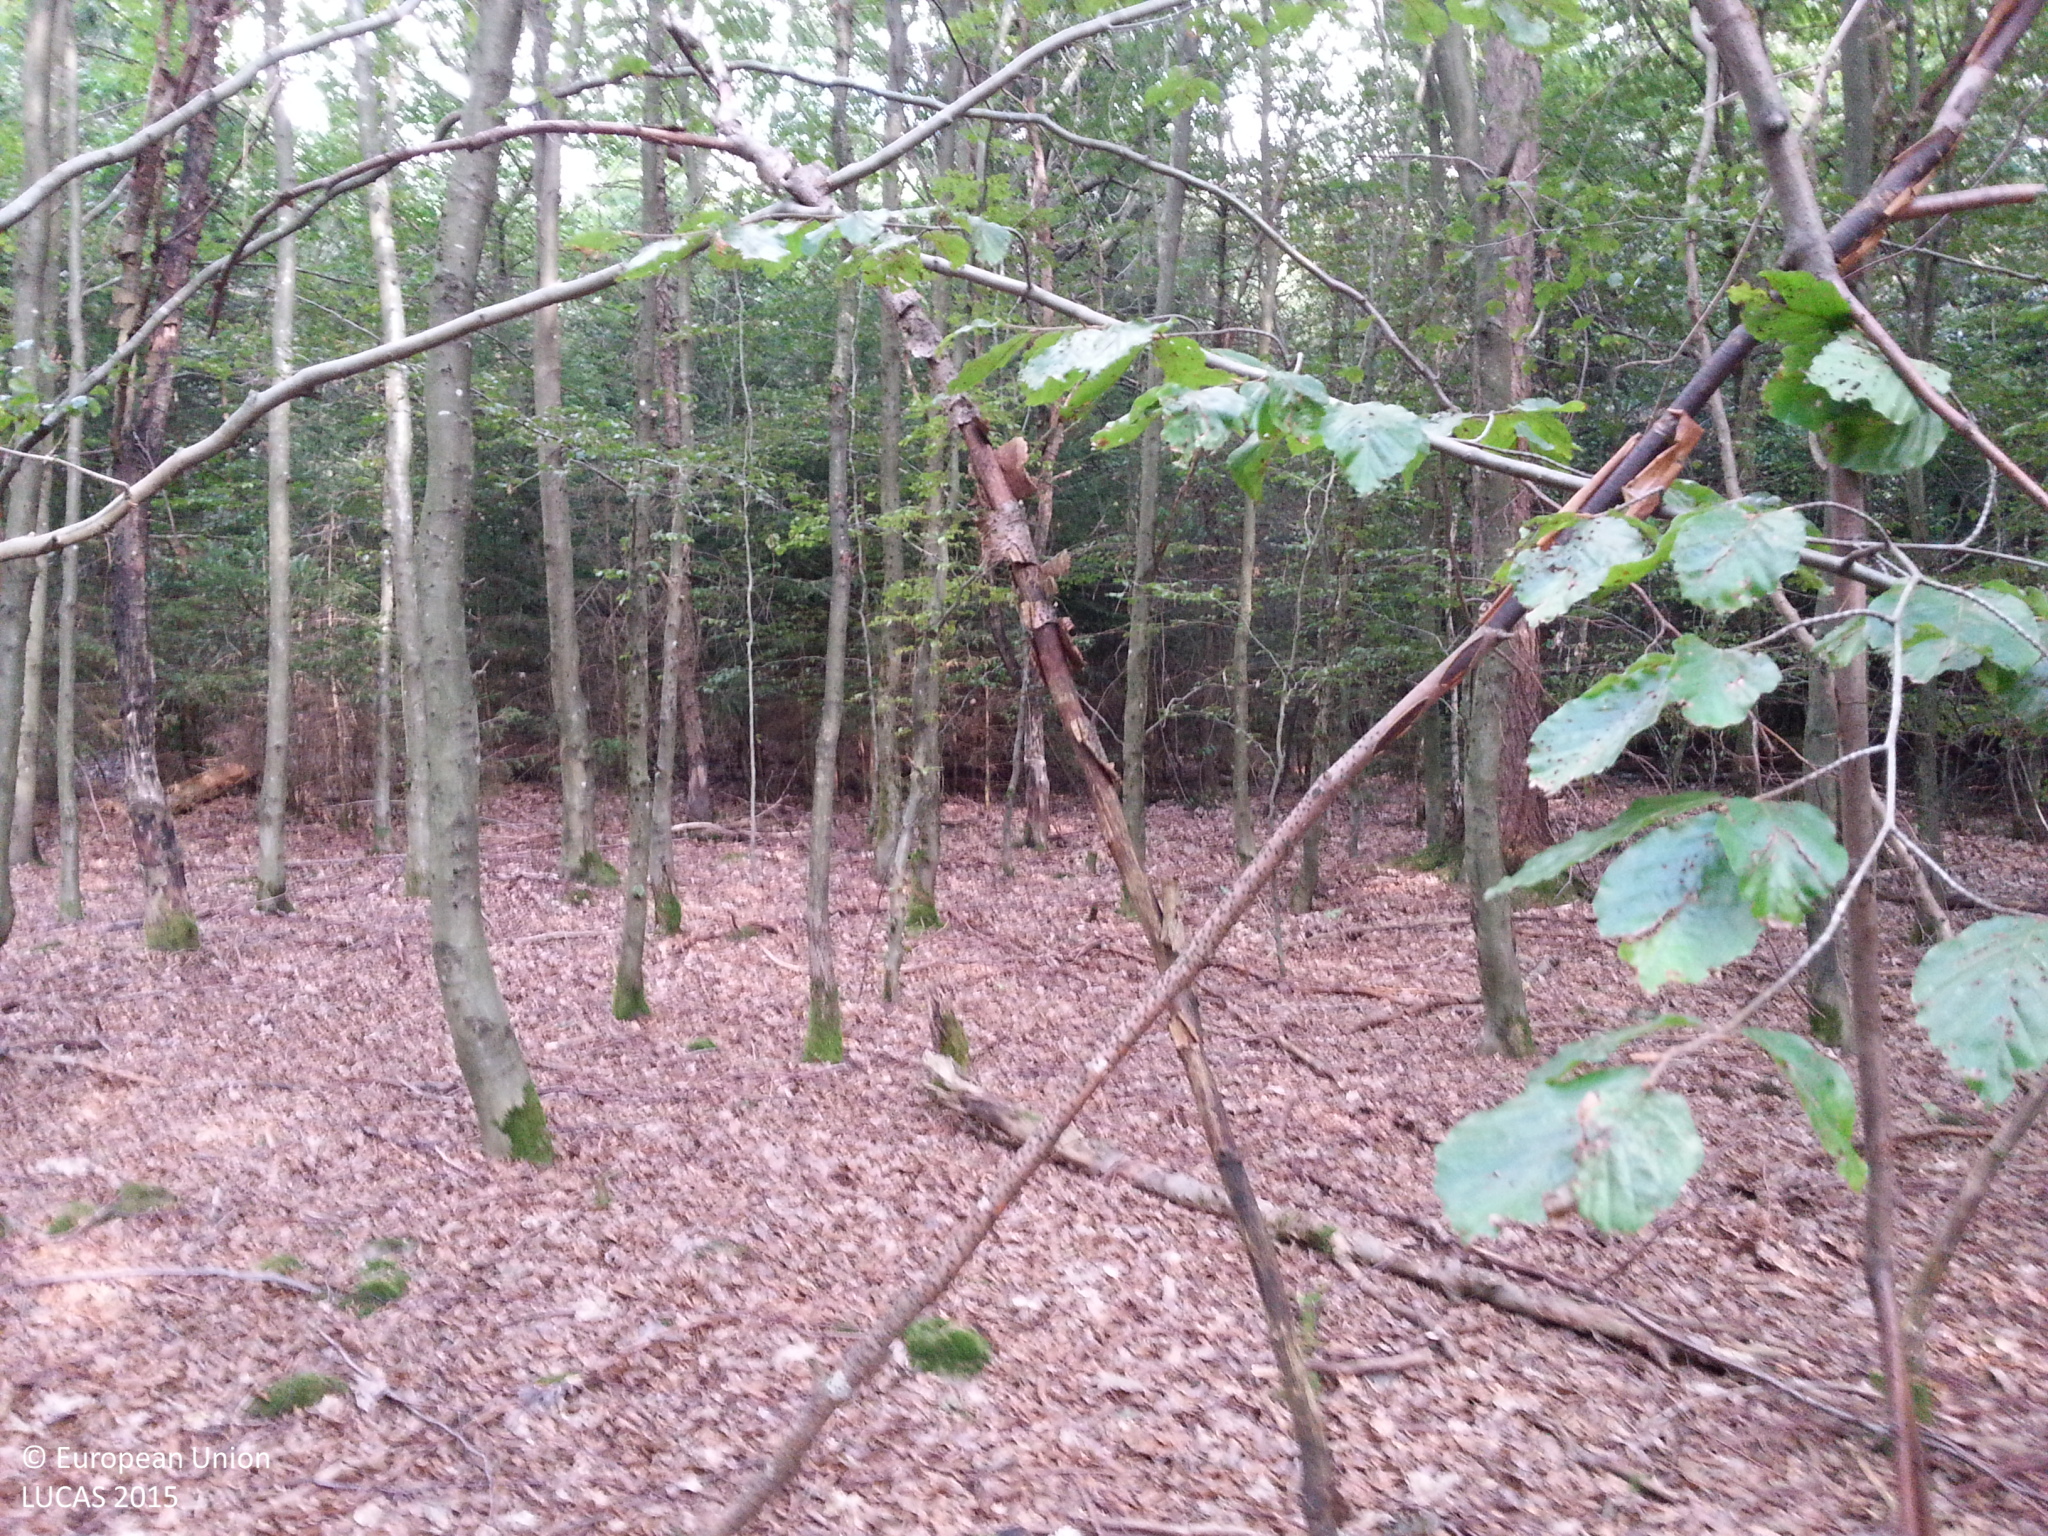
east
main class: Woodland
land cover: Broadleaved woodland
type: beech forest
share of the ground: > 75 %
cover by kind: broadleaved forest trees 85 %, unconsolidated bare surface 15 %
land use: Forestry
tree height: > 5 m
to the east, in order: Broadleaved woodland; Pine dominated mixed woodland; Broadleaved woodland; Tracks; Grassland without tree/shrub cover; Other bare soil
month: September
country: DE
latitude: 49.5339
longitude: 9.1851
